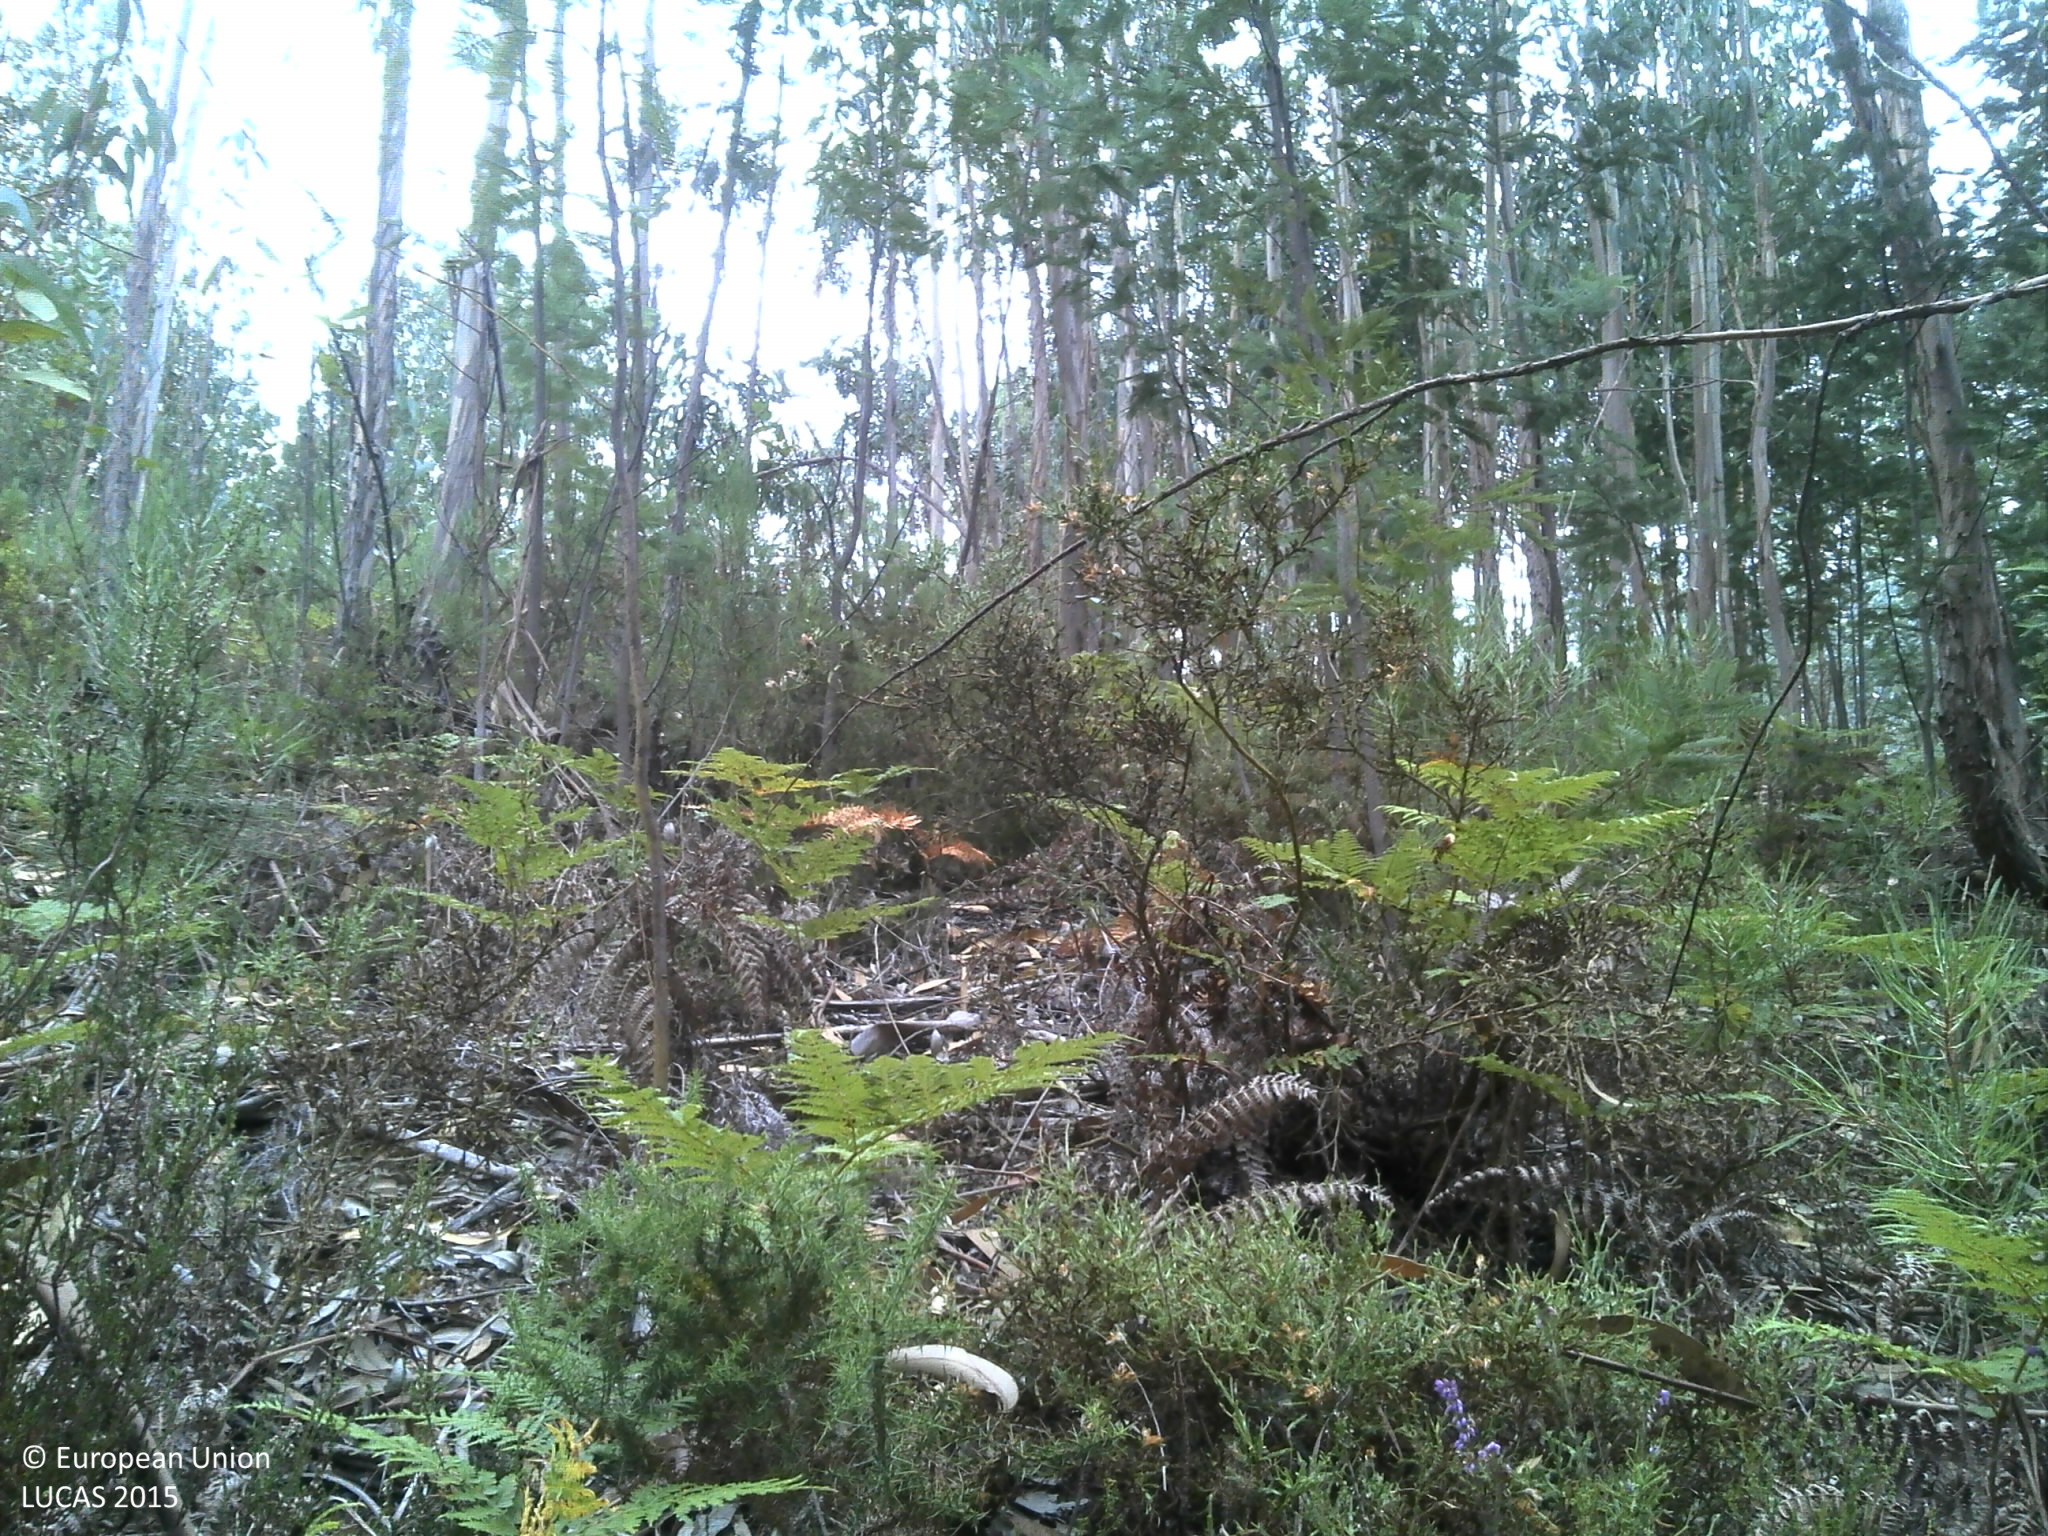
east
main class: Woodland
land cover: Broadleaved woodland
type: exotic forest
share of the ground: 50 - 75 %
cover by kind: broadleaved forest trees 60 %, consolidated bare surface 20 %, shrubs 10 %, unconsolidated bare surface 10 %
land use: Forestry
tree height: > 5 m
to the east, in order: Broadleaved woodland; Tracks; Broadleaved woodland; Paved roads, cycling and walking lanes; Broadleaved woodland; Tracks; Broadleaved woodland; Tracks; Broadleaved woodland
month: July
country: PT
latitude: 40.2902
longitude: -8.2785
